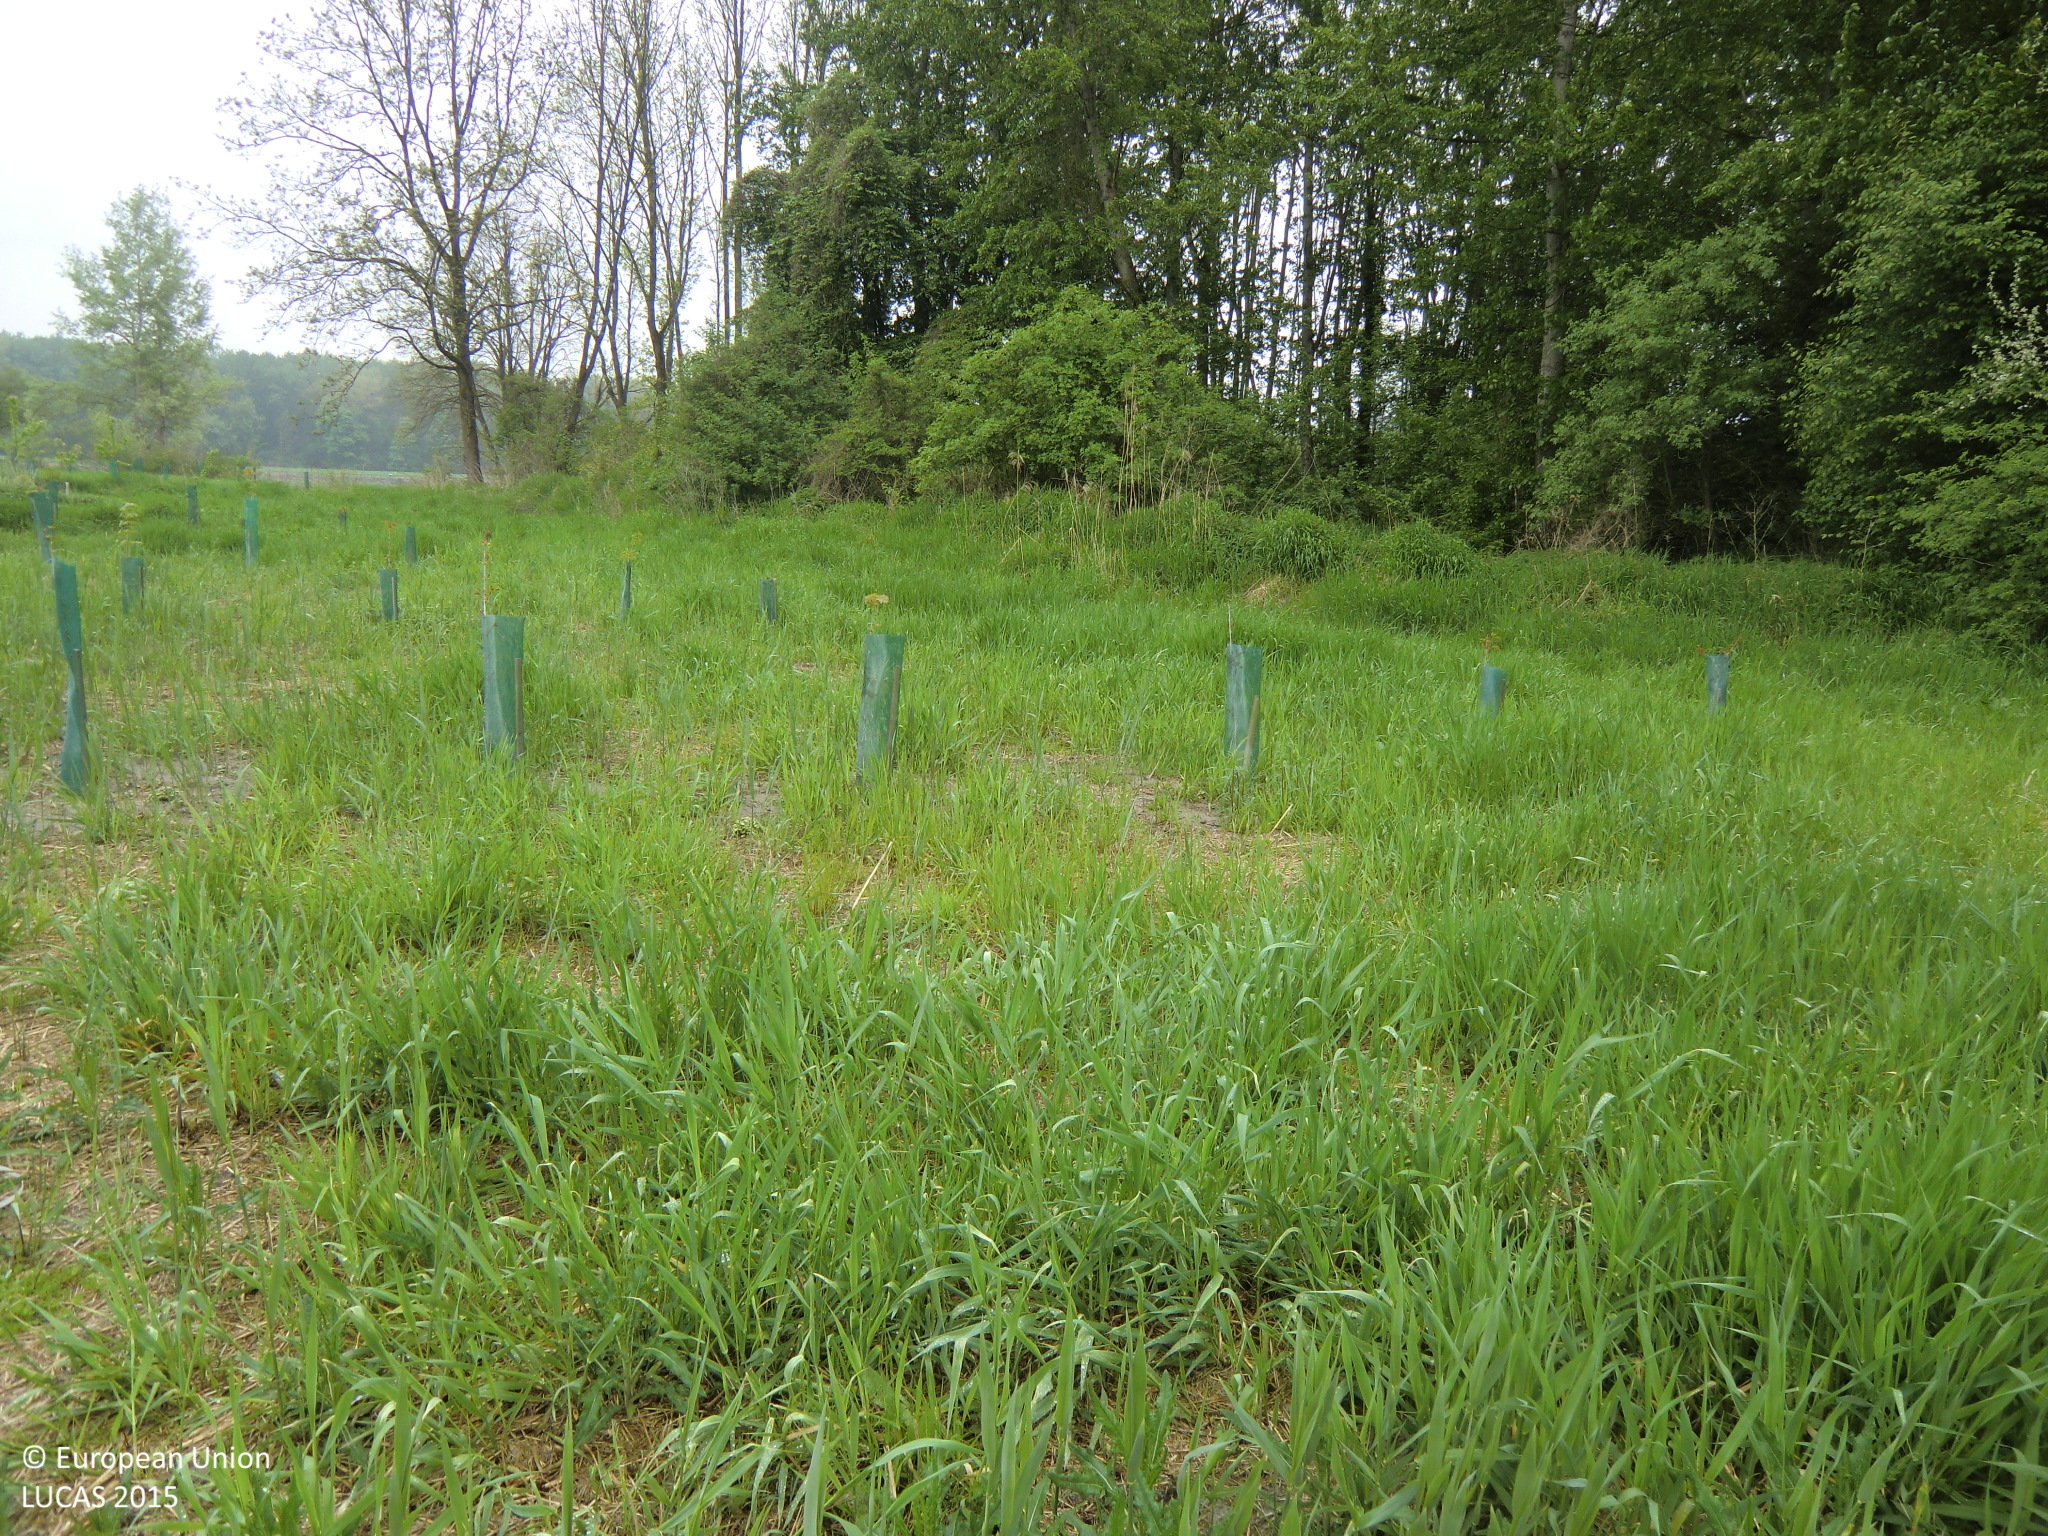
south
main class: Cropland
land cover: Nurseries
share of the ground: < 10 %
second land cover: Spontaneously vegetated surfaces
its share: > 75 %
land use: Forestry
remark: Temporary flooded
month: May
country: AT
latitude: 48.1765
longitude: 14.7210
